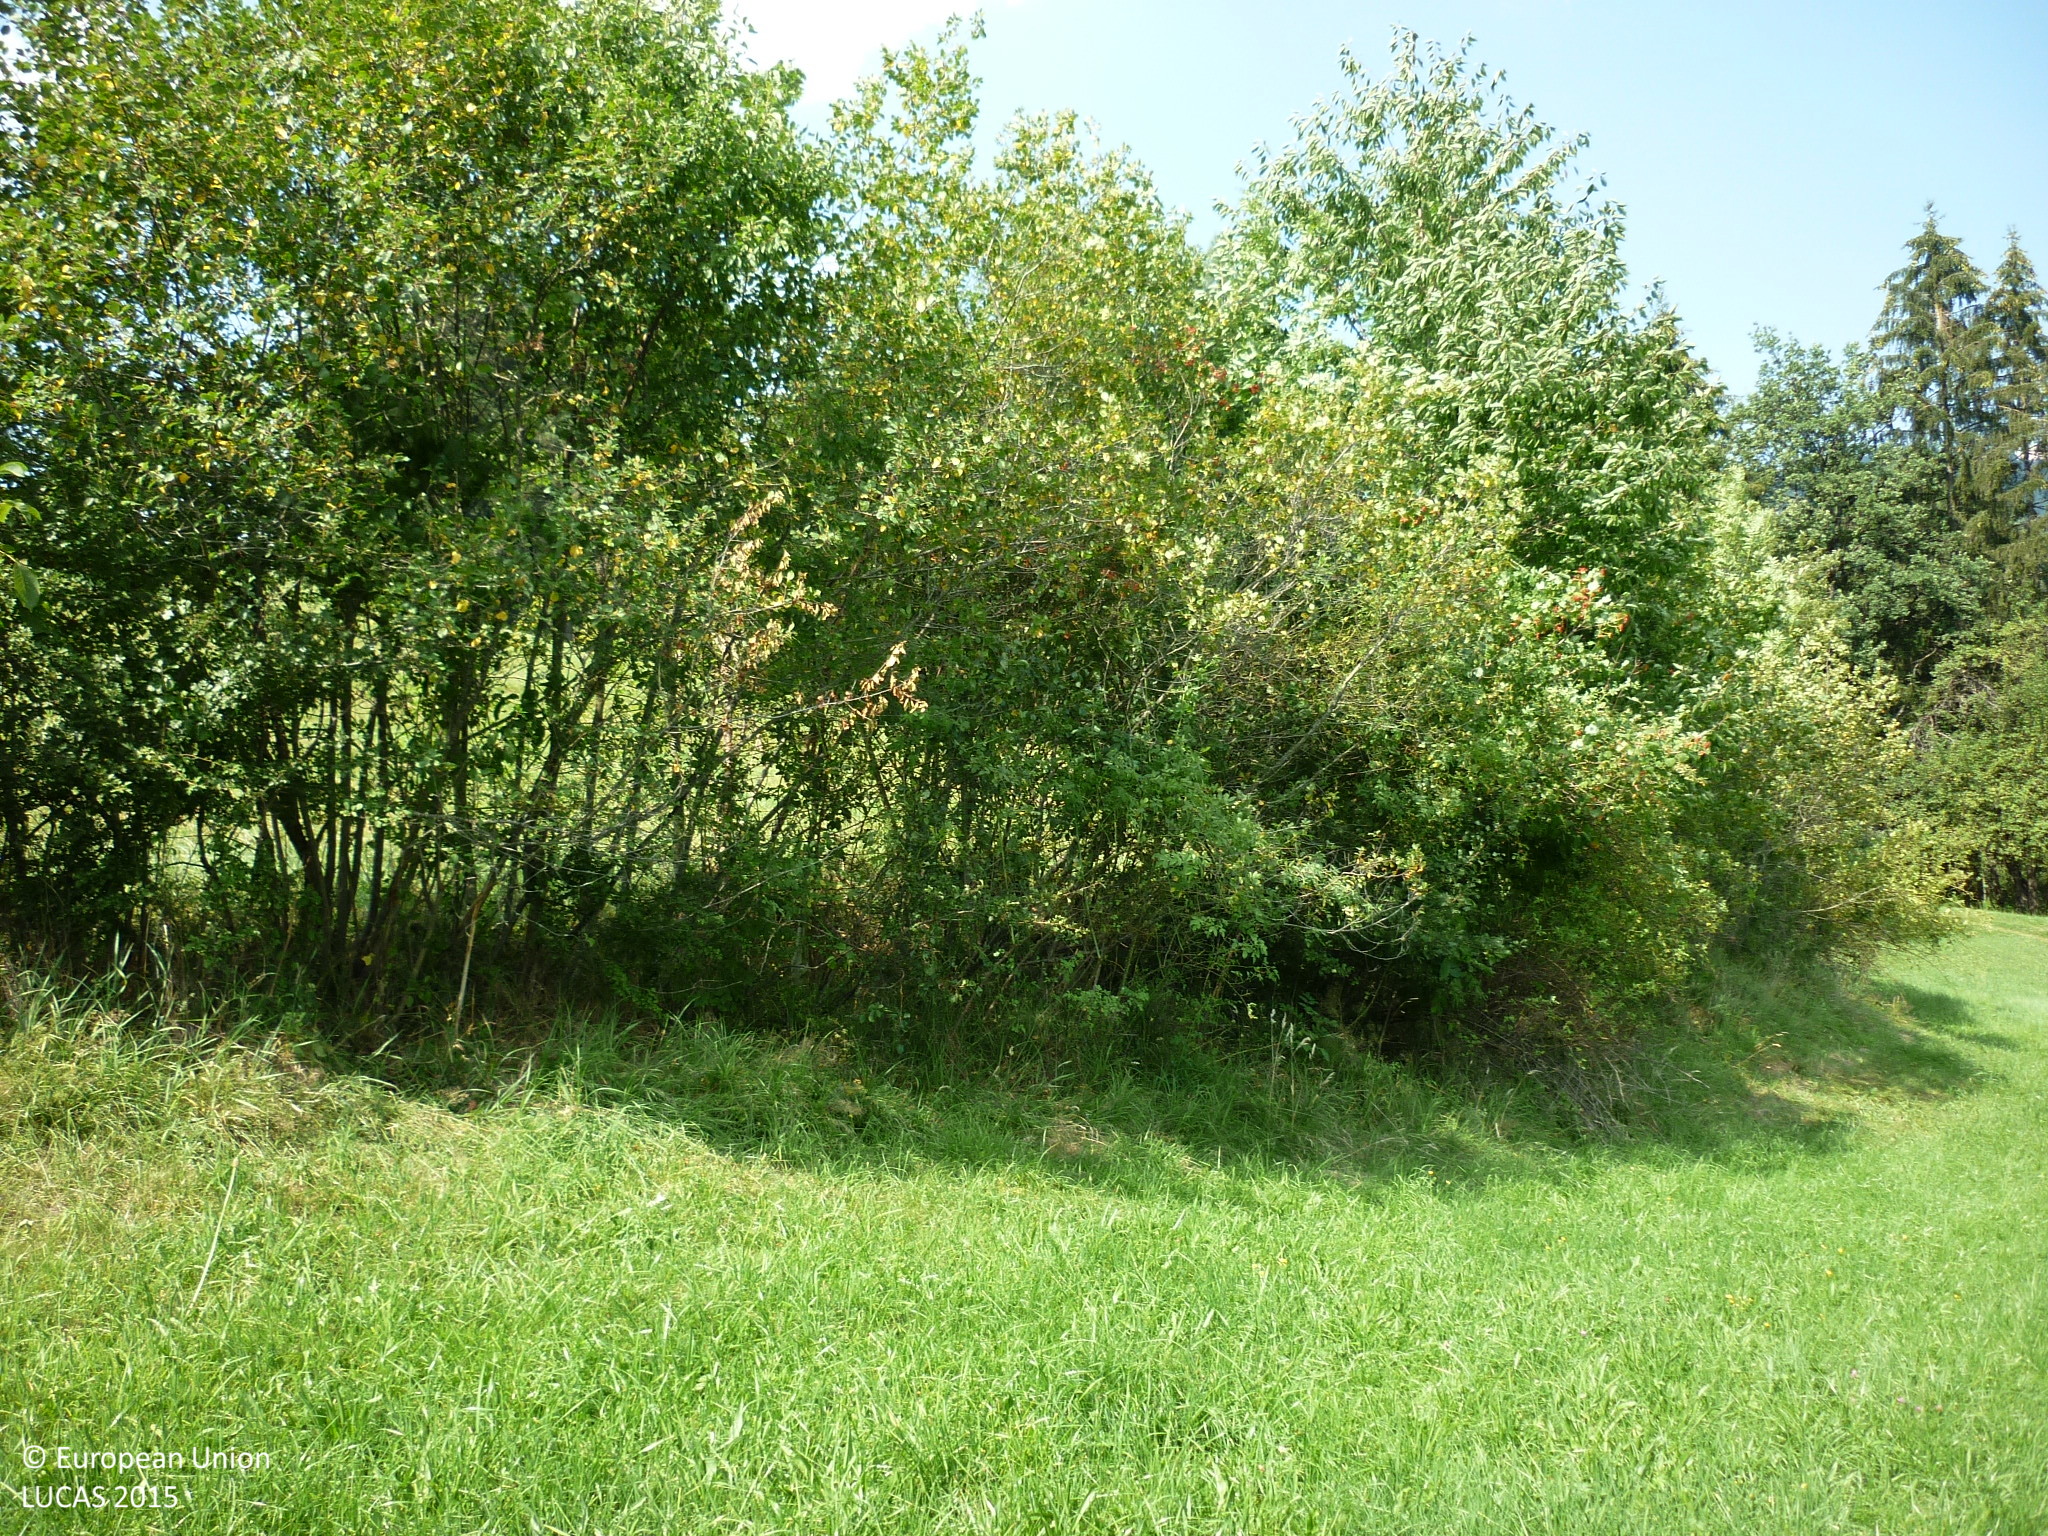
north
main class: Grassland
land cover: Grassland without tree/shrub cover
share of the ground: > 75 %
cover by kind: herbaceous plants 100 %
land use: Agriculture (excluding fallow land and kitchen gardens)
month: August
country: AT
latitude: 47.7112
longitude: 14.1977
